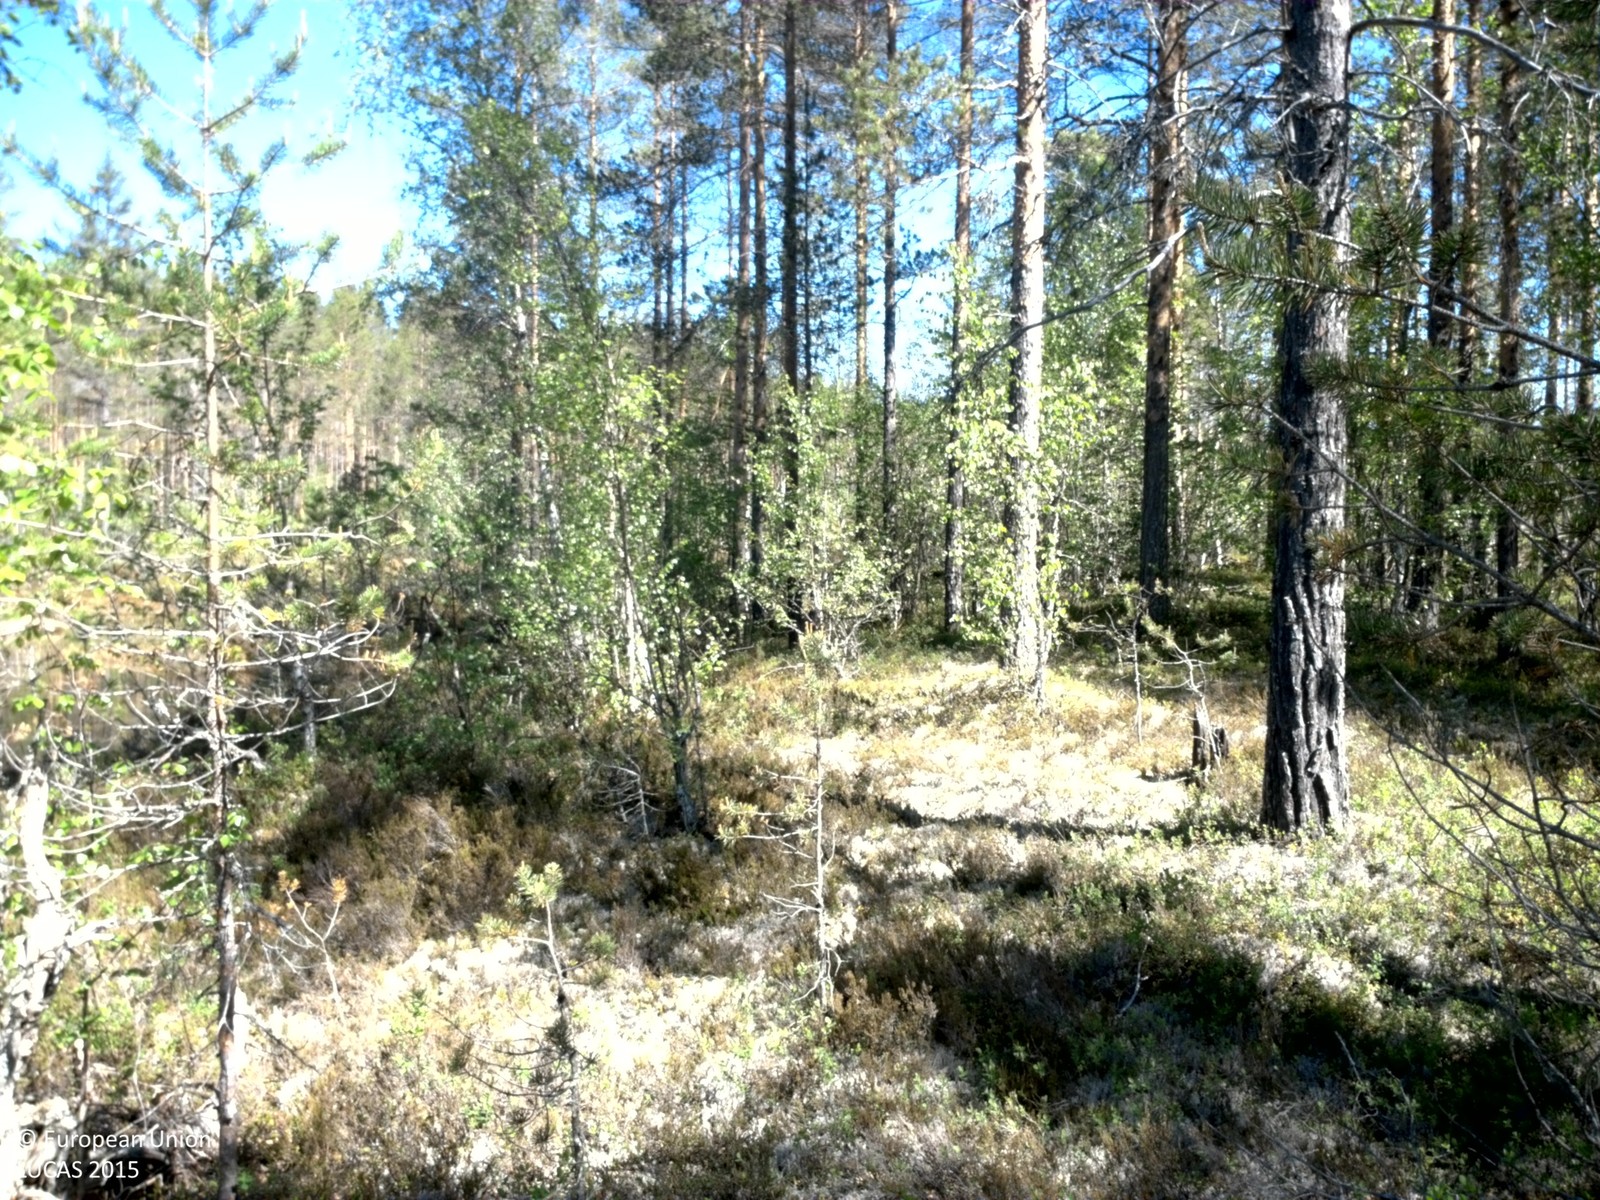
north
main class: Woodland
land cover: Pine dominated coniferous woodland
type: boreal forest
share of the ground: 50 - 75 %
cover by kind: coniferous forest trees 50 %, broadleaved forest trees 15 %, shrubs 15 %, herbaceous plants 15 %, lichens and mosses 5 %
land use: Forestry
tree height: < 5 m
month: June
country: SE
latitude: 61.3228
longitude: 13.6674
